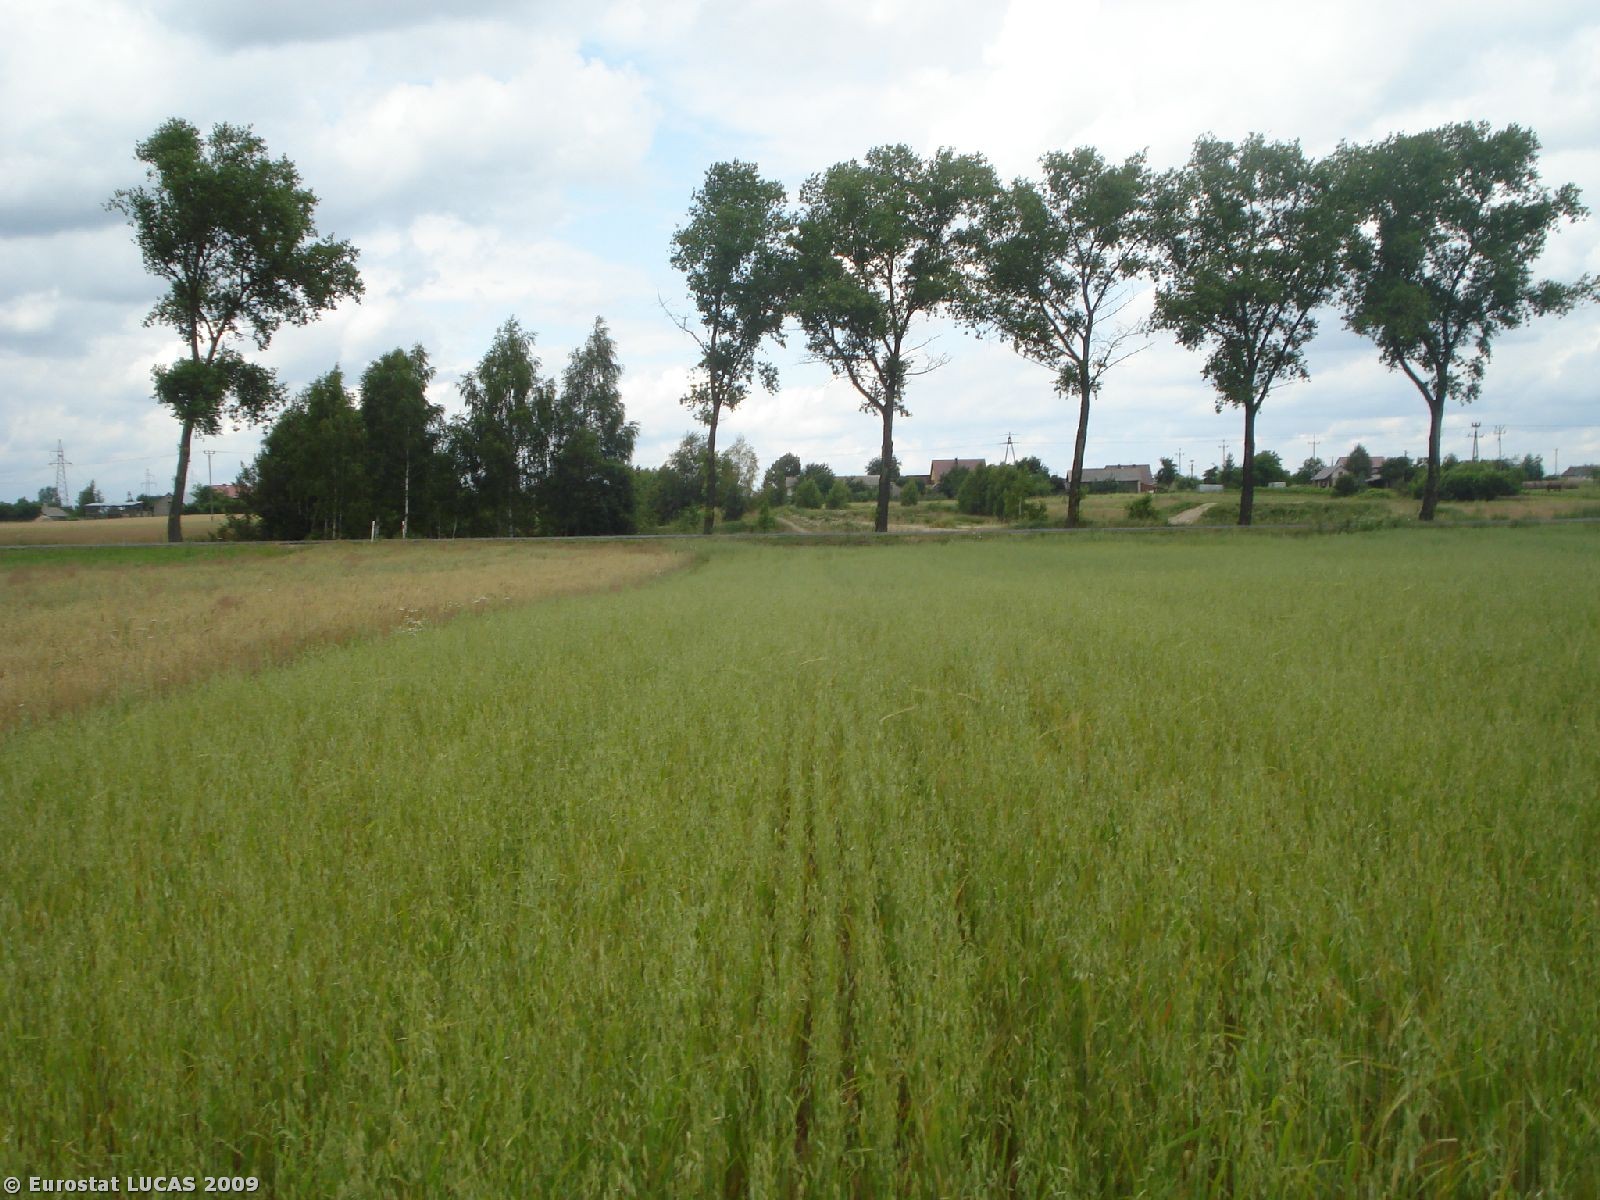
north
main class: Cropland
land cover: Oats
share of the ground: > 75 %
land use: Agriculture (excluding fallow land and kitchen gardens)
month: July
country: PL
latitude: 51.2883
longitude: 23.0528
